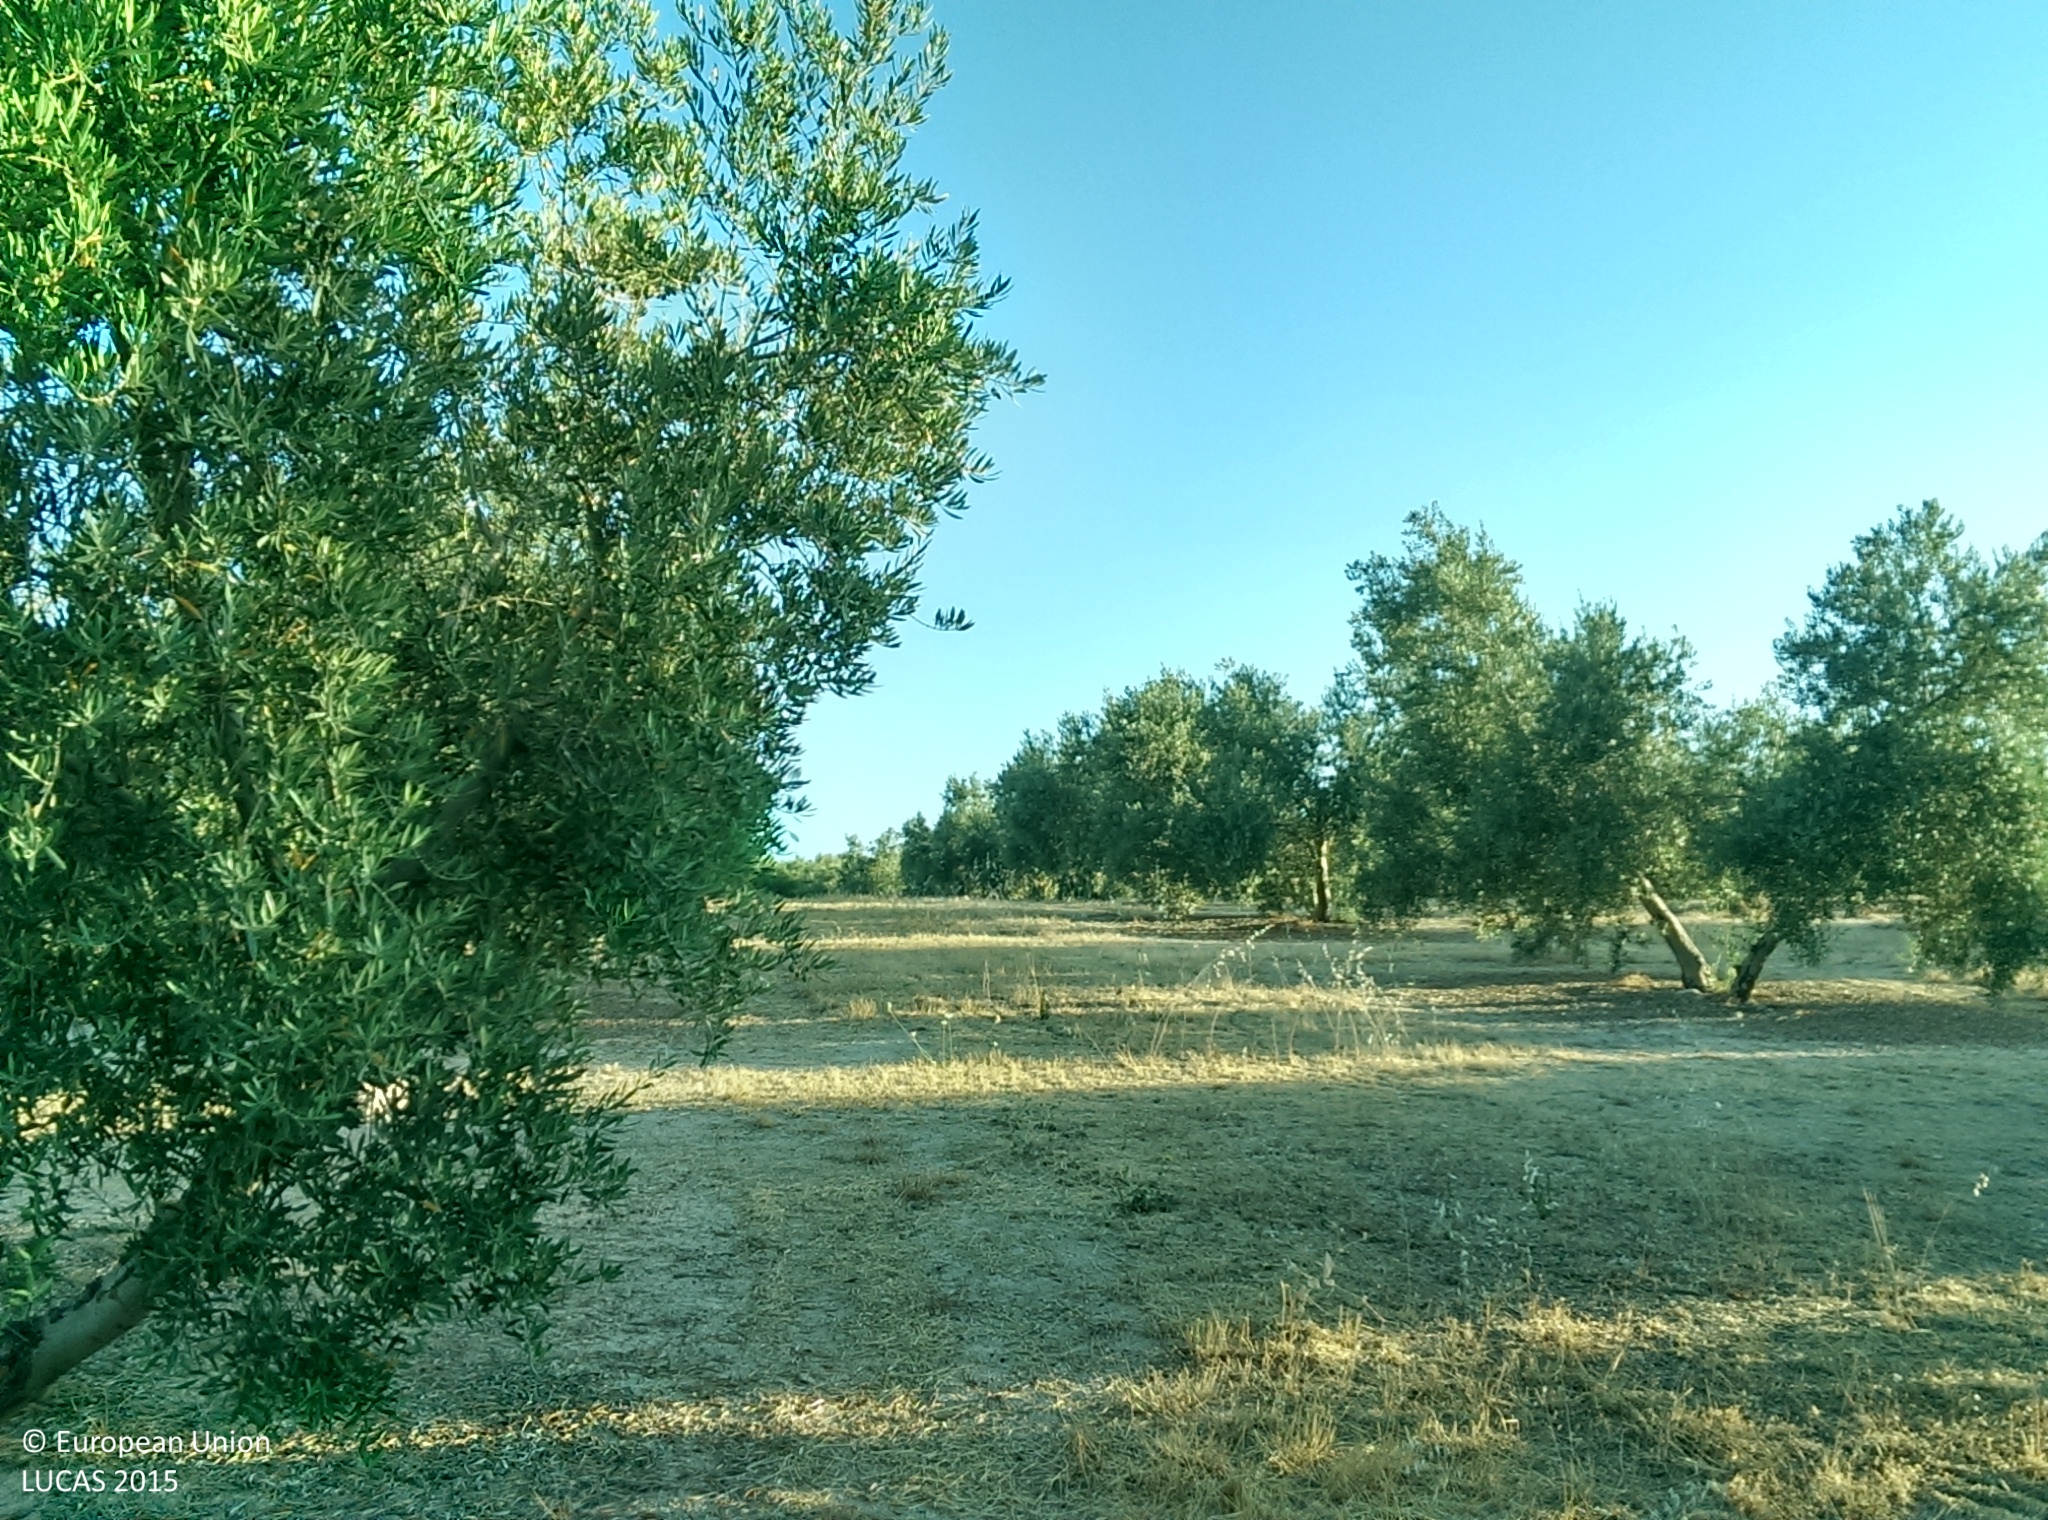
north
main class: Cropland
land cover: Olive groves
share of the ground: 25 - 50 %
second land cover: Spontaneously vegetated surfaces
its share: 10 - 25 %
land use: Agriculture (excluding fallow land and kitchen gardens)
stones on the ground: 10 - 25 %
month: July
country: ES
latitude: 37.4025
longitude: -3.7654
